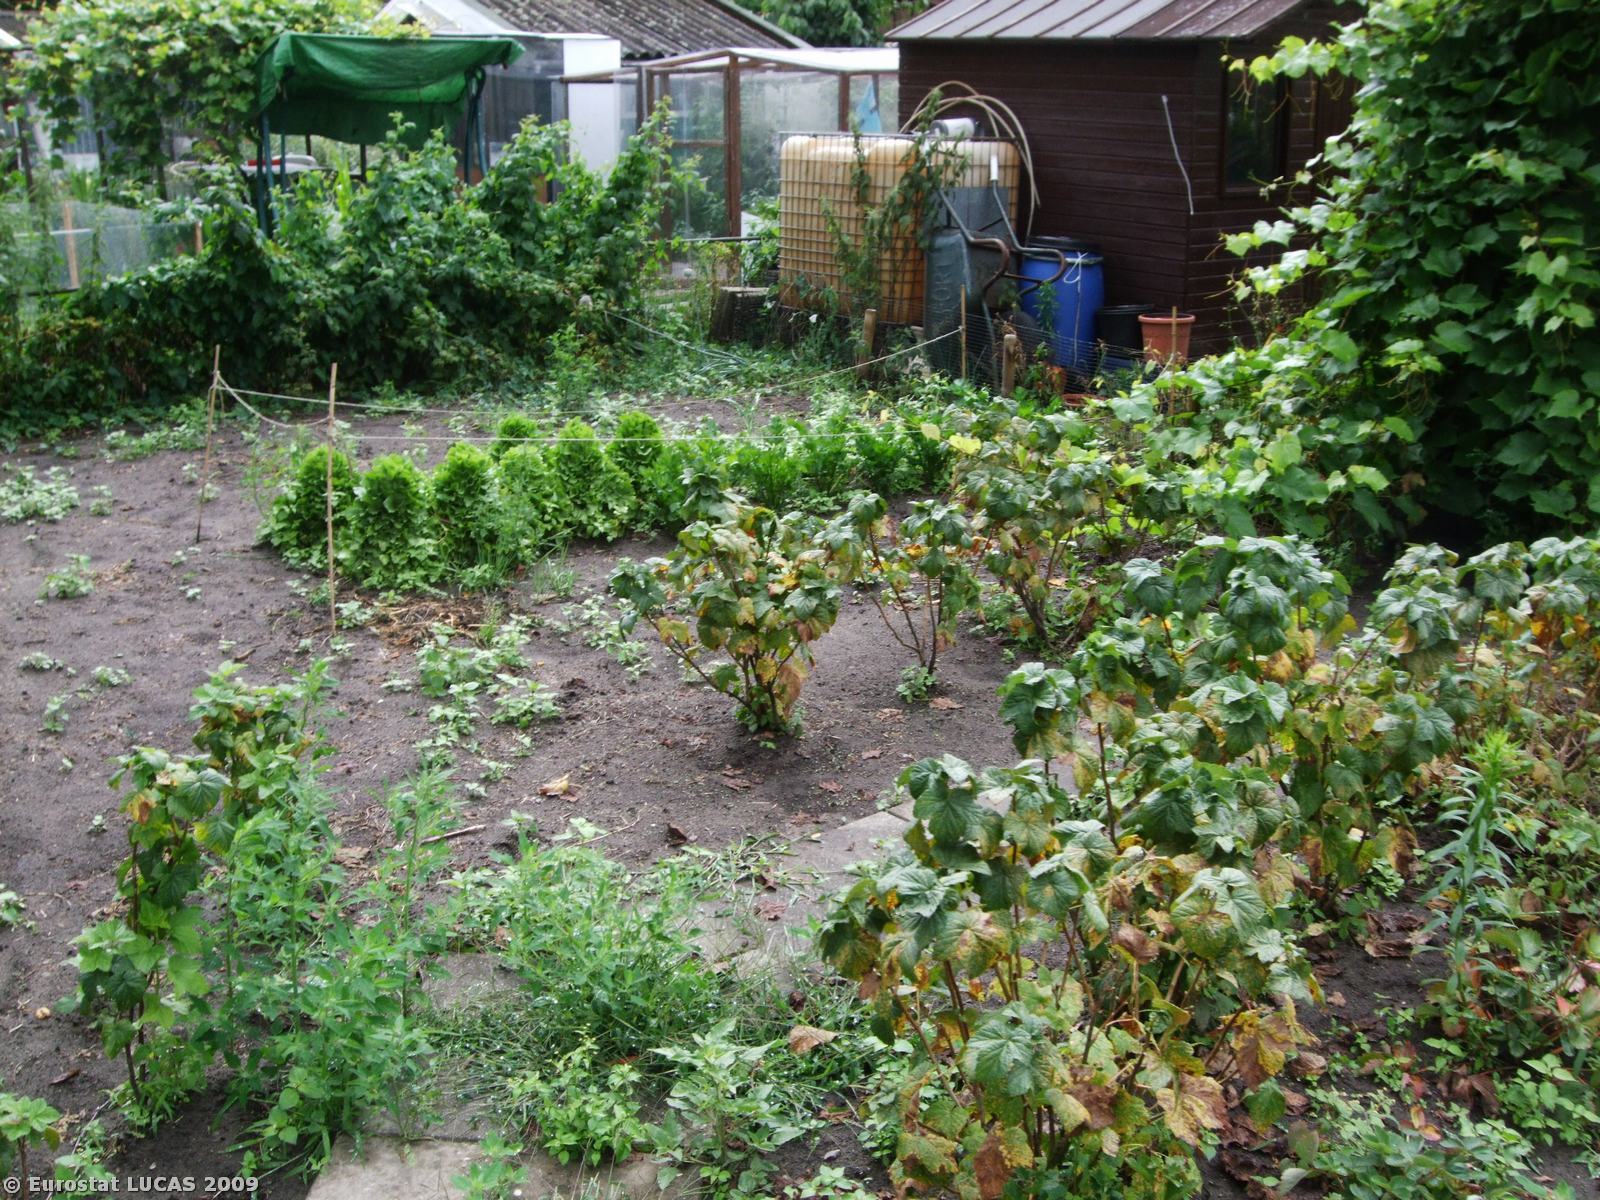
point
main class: Artificial land
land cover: Buildings with 1 to 3 floors
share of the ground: 10 - 25 %
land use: Amenities, museums, leisure
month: July
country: NL
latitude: 51.4714
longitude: 5.6940
